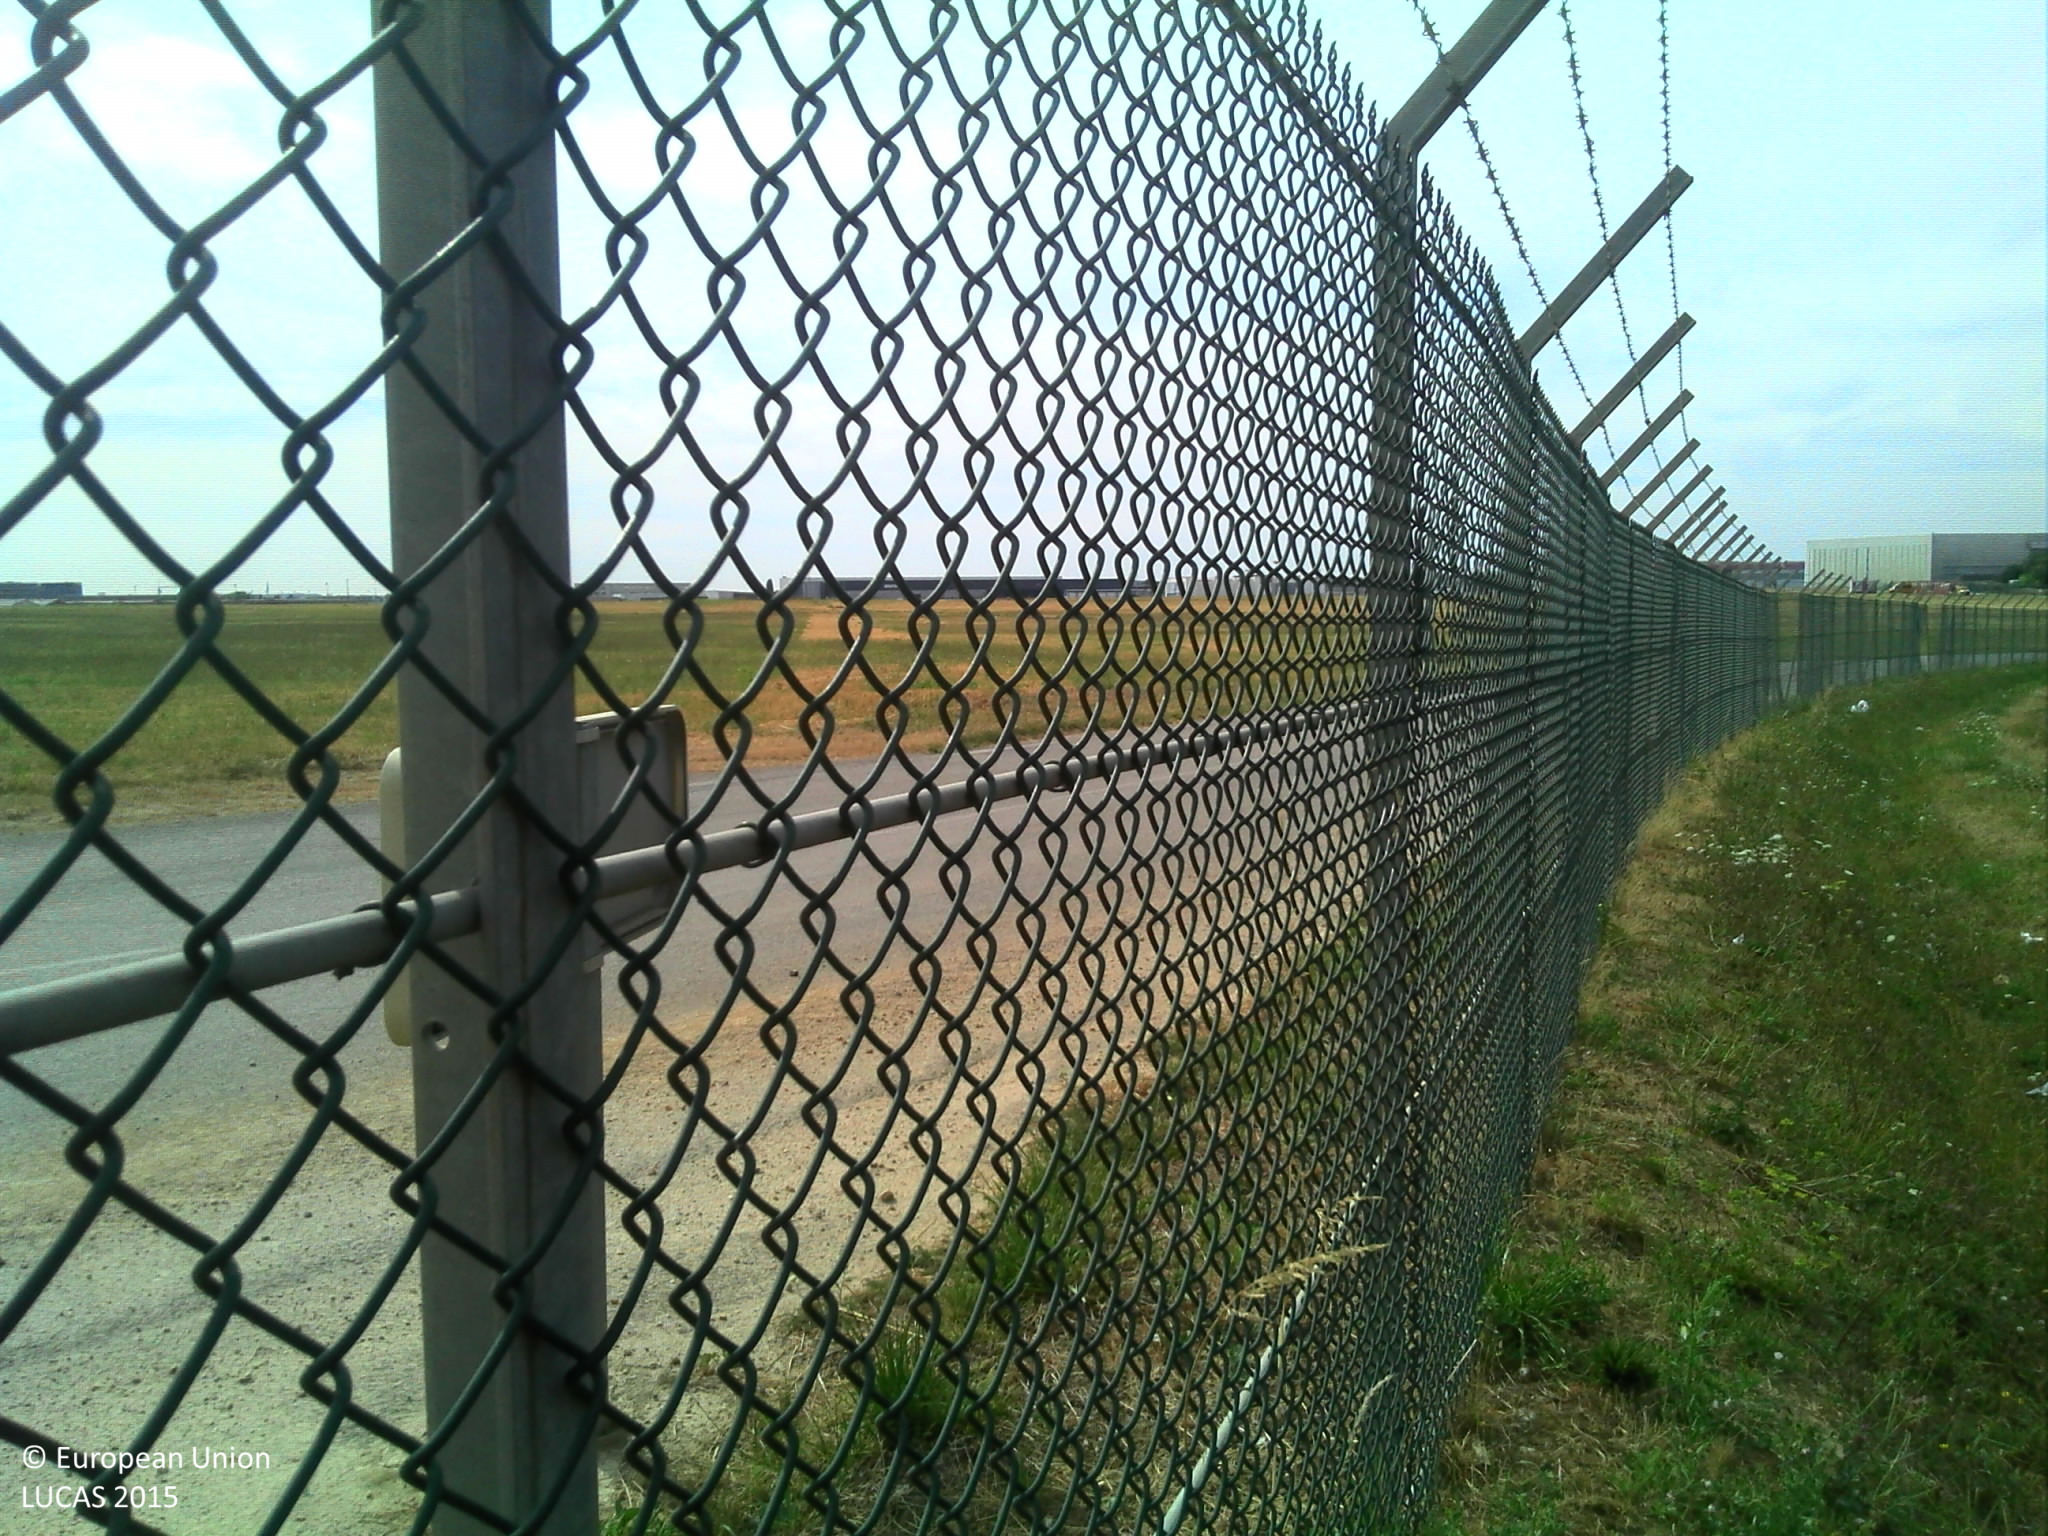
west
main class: Grassland
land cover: Grassland without tree/shrub cover
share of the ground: > 75 %
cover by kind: herbaceous plants 100 %
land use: Air transport
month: August
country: FR
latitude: 48.7372
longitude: 2.3874
